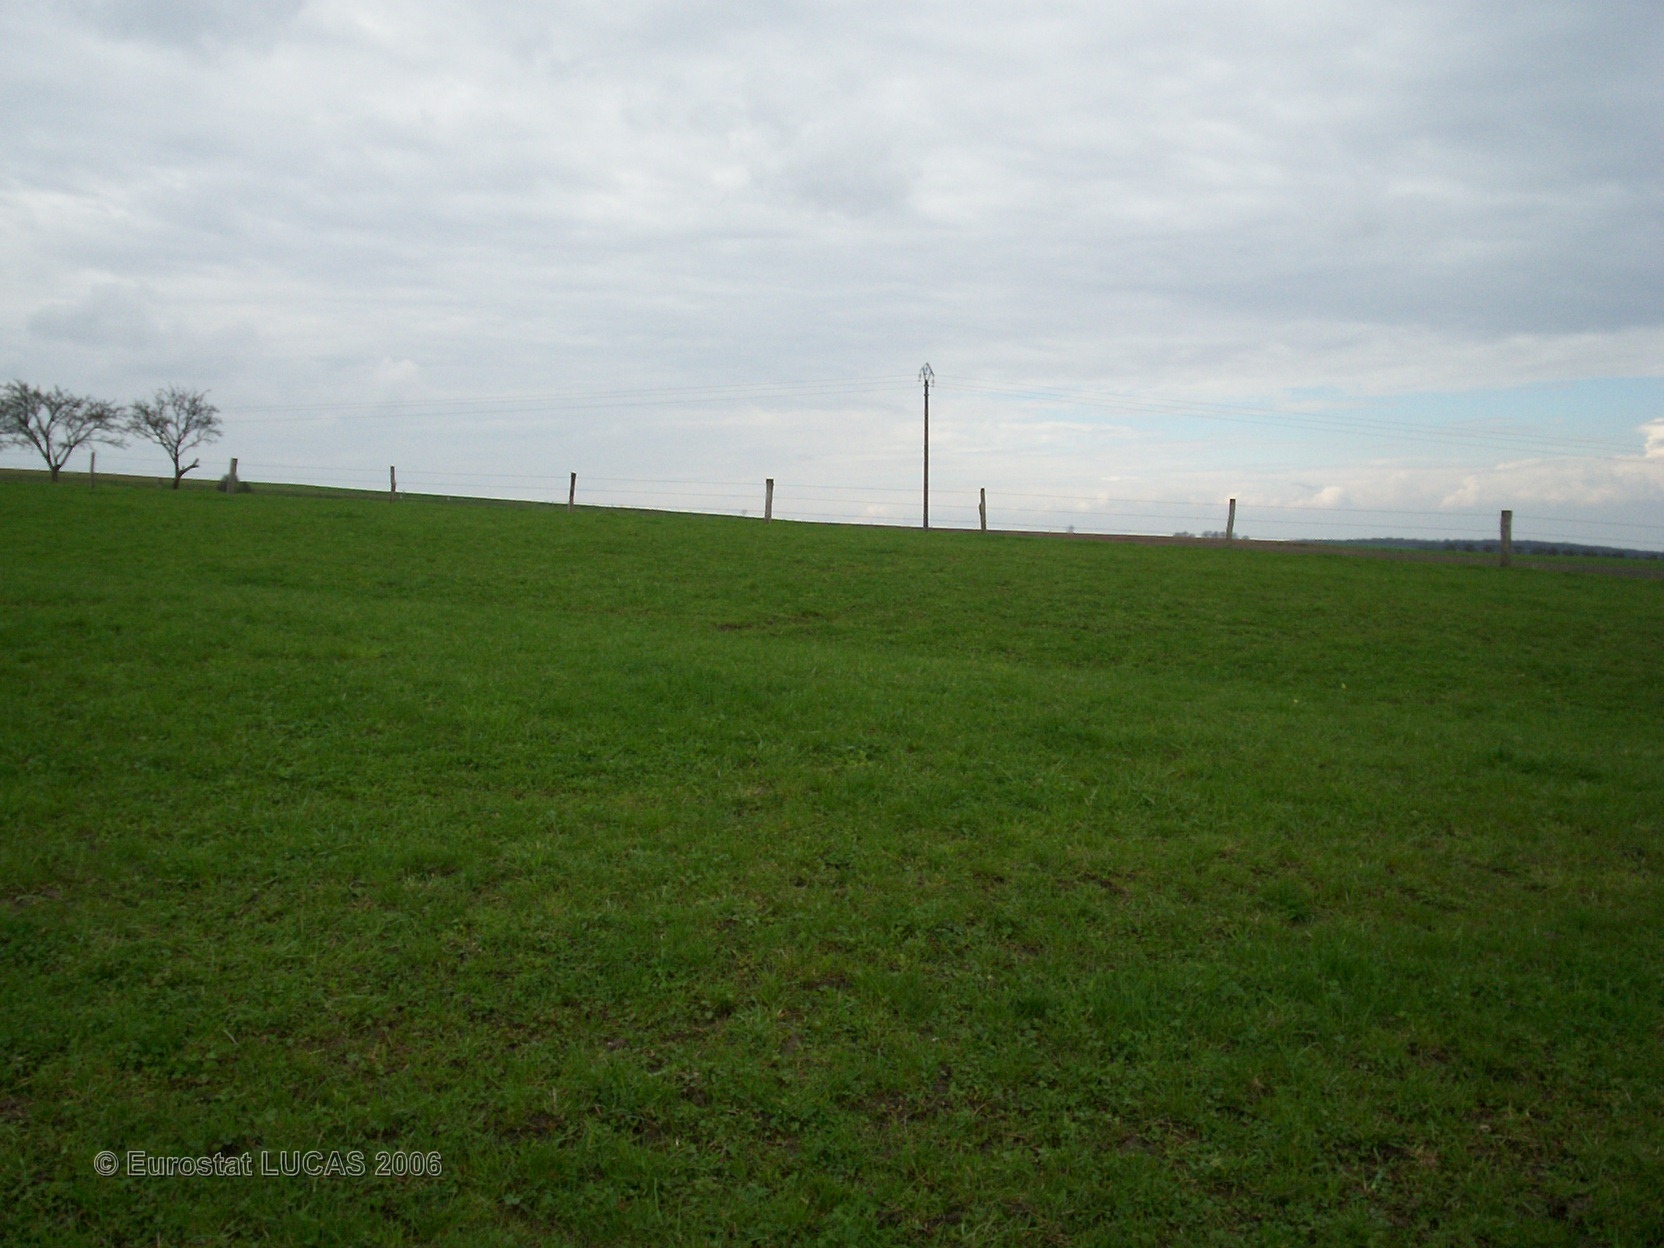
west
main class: Grassland
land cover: Grassland without tree/shrub cover
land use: Agriculture (excluding fallow land and kitchen gardens)
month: April
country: FR
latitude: 48.2411
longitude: 6.0011
